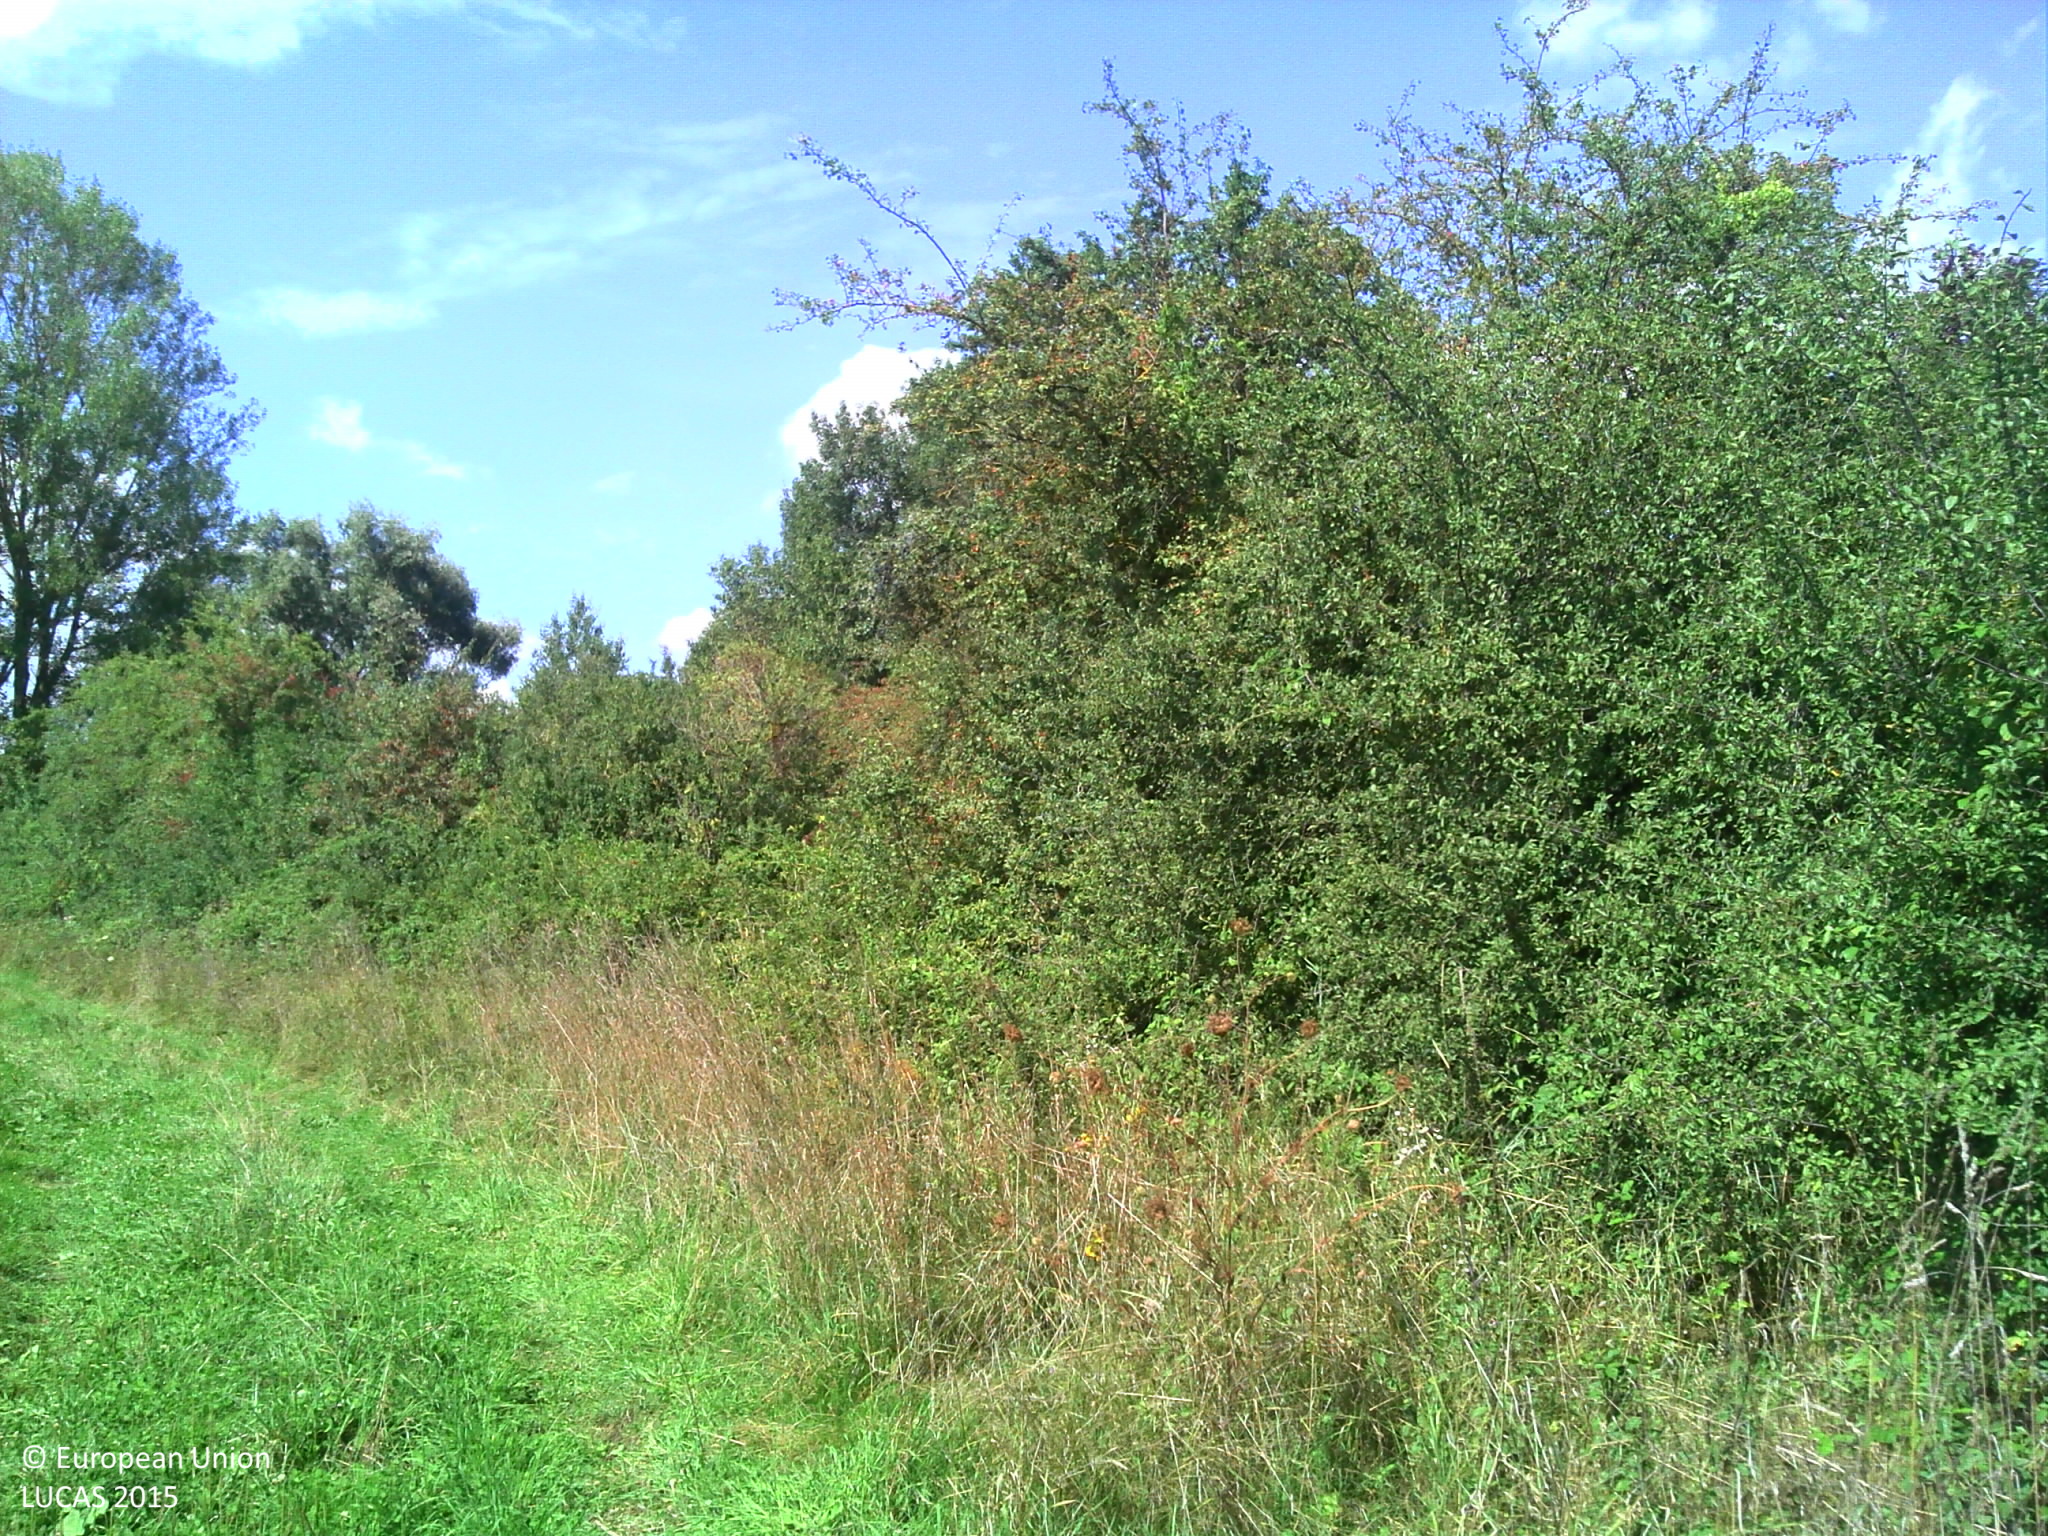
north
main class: Grassland
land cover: Spontaneously vegetated surfaces
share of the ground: > 75 %
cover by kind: herbaceous plants 95 %, shrubs 5 %
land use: Semi-natural and natural areas not in use
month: August
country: FR
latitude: 46.5750
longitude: 3.3043
